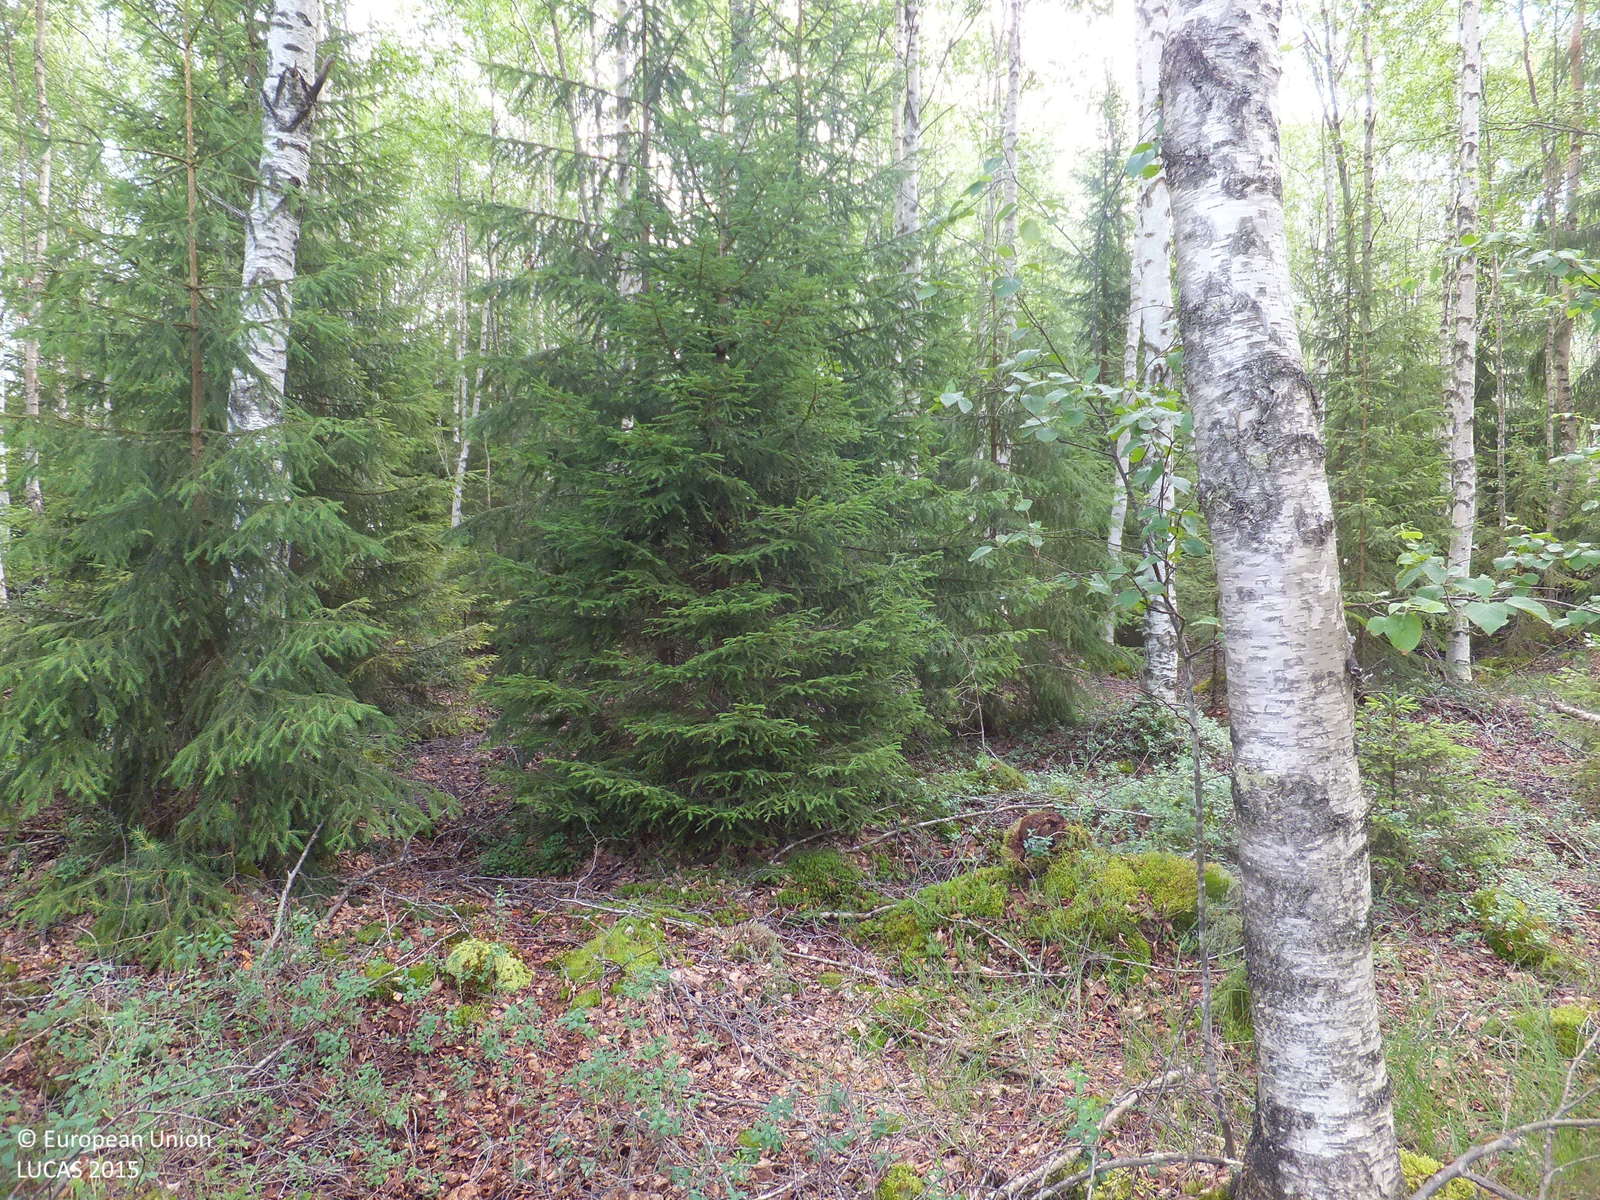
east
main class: Woodland
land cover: Spruce dominated mixed woodland
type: boreal forest
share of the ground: > 75 %
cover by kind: broadleaved forest trees 50 %, coniferous forest trees 40 %, shrubs 5 %, lichens and mosses 5 %
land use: Forestry
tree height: > 5 m
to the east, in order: Spruce dominated mixed woodland; Ditches and canals; Spruce dominated mixed woodland; Ditches and canals; Spruce dominated mixed woodland; Ditches and canals; Spruce dominated mixed woodland; Pine dominated mixed woodland; Broadleaved woodland
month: July
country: FI
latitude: 63.6211
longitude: 23.2296
